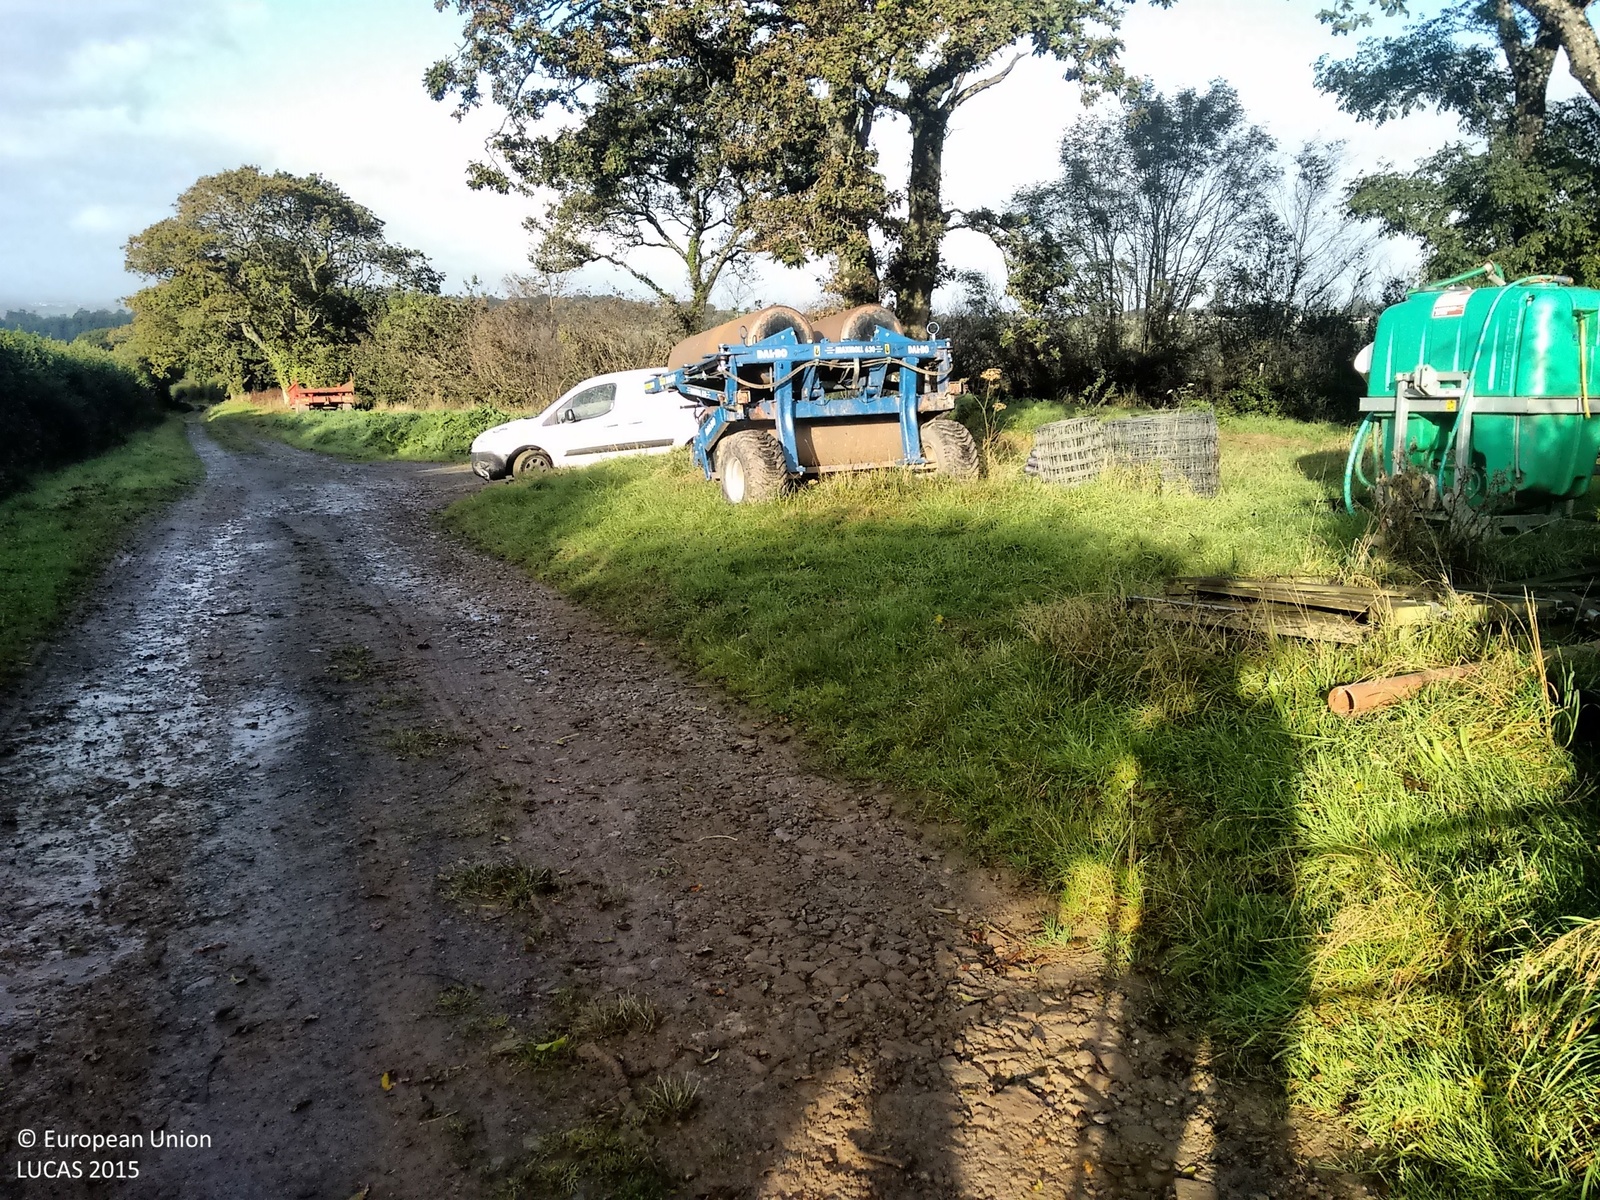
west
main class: Grassland
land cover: Grassland without tree/shrub cover
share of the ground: > 75 %
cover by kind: herbaceous plants 100 %
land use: Agriculture (excluding fallow land and kitchen gardens)
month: September
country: GB
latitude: 50.7013
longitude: -4.1569
